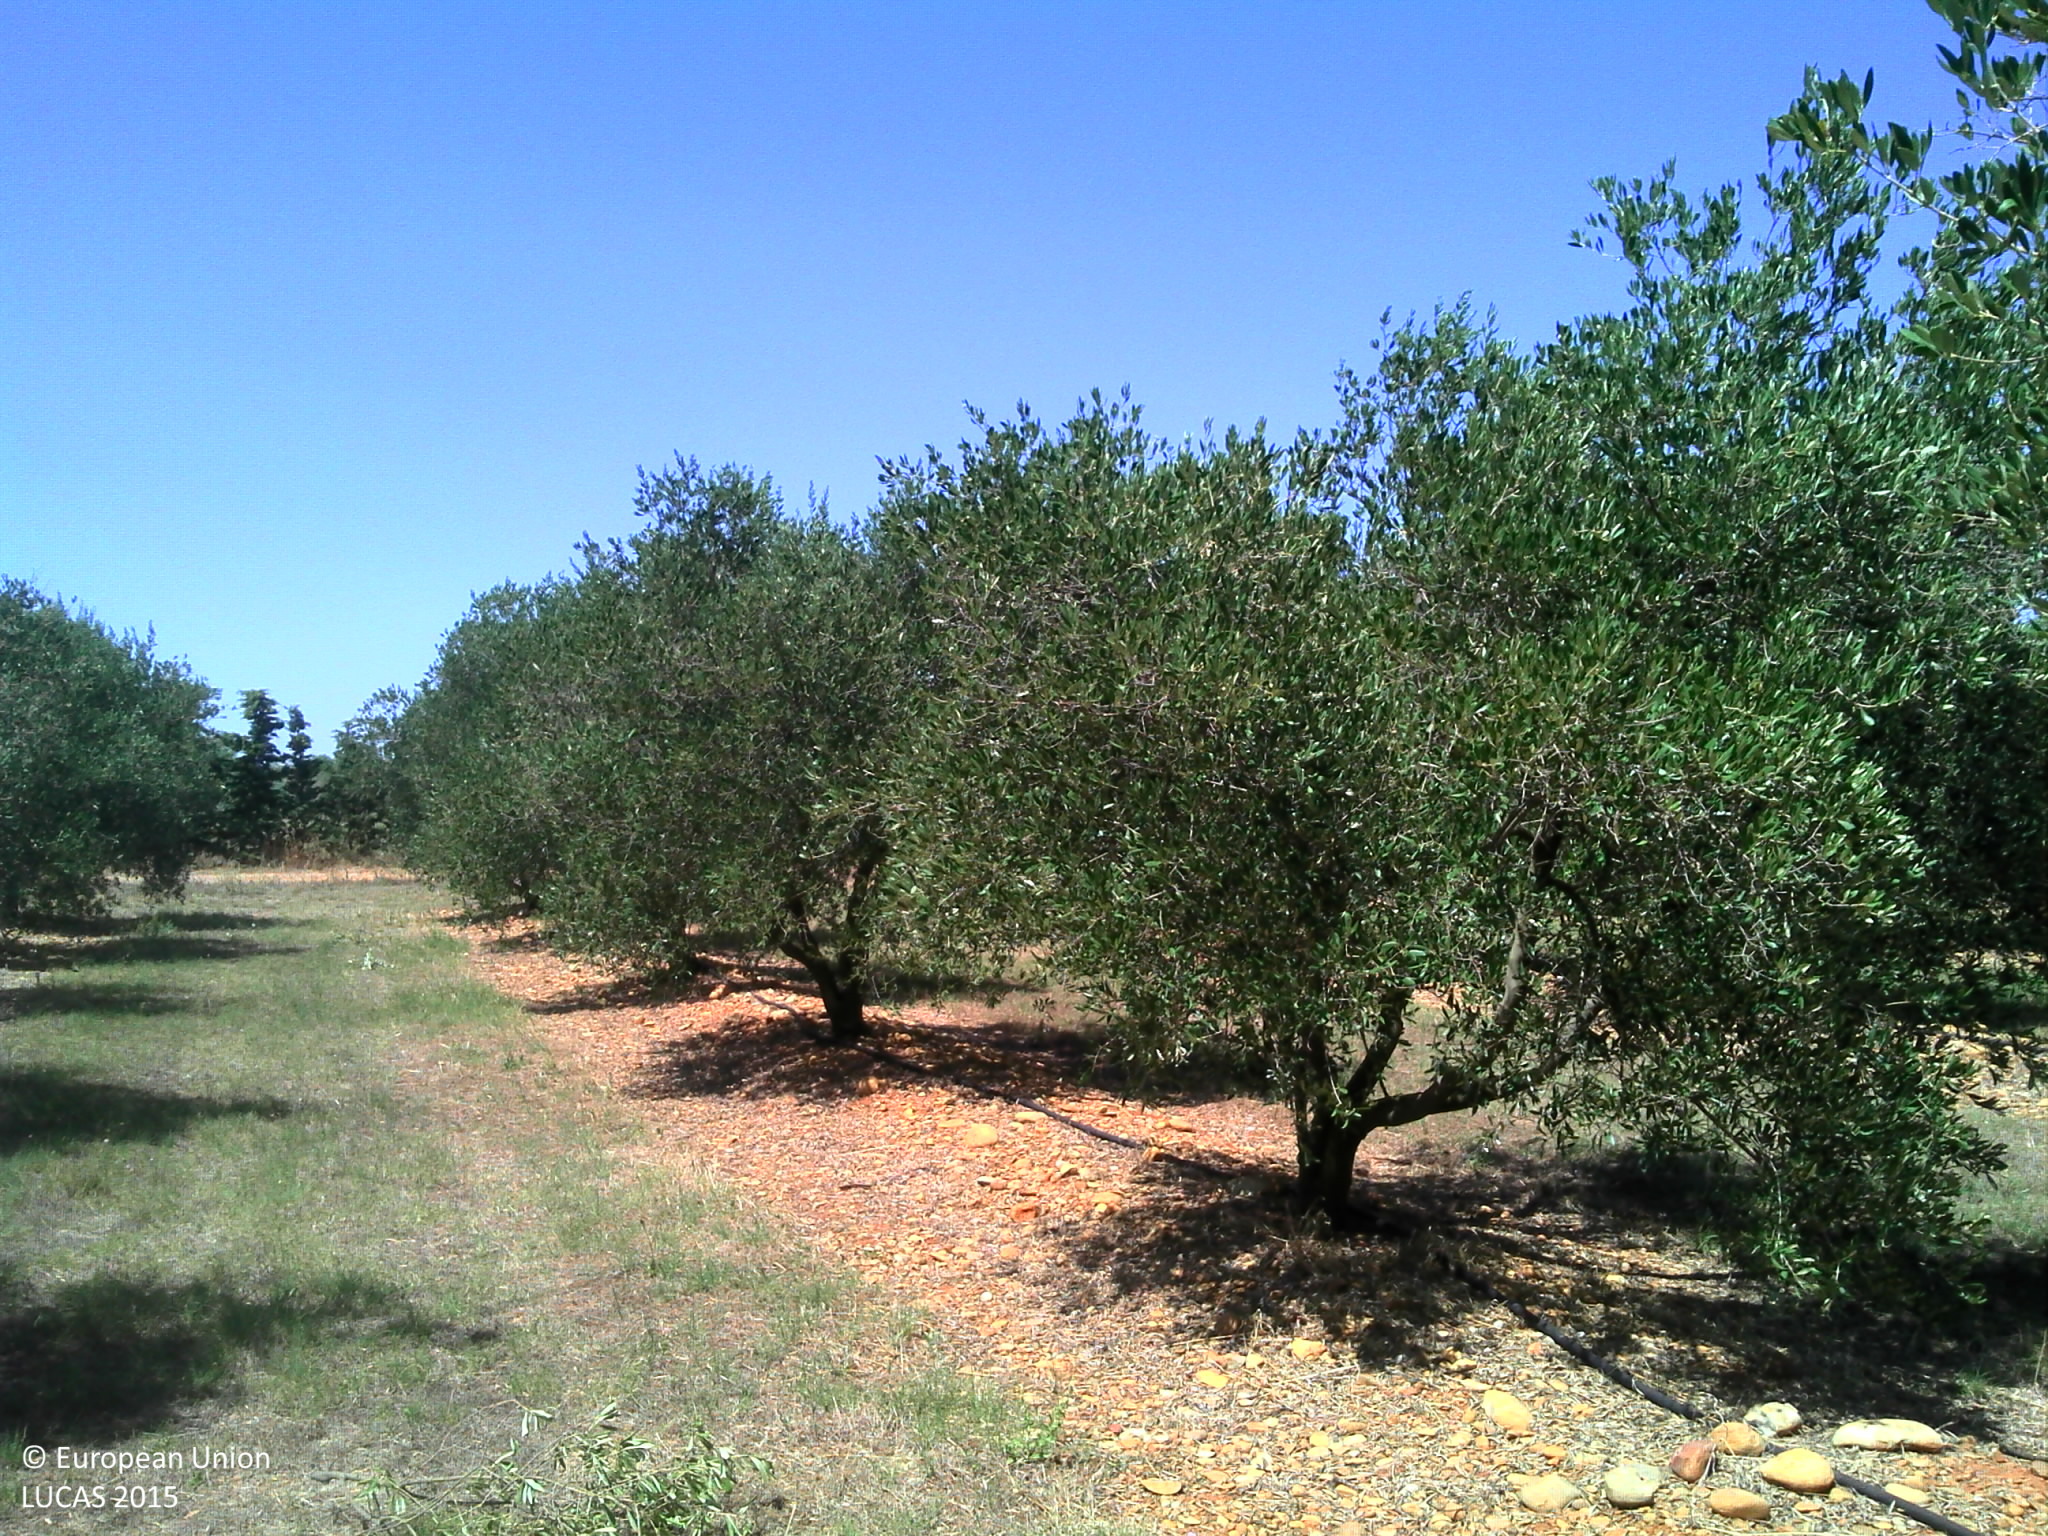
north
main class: Cropland
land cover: Olive groves
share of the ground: 25 - 50 %
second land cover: Grassland without tree/shrub cover
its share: > 75 %
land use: Agriculture (excluding fallow land and kitchen gardens)
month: July
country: FR
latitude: 43.6761
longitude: 4.7627
